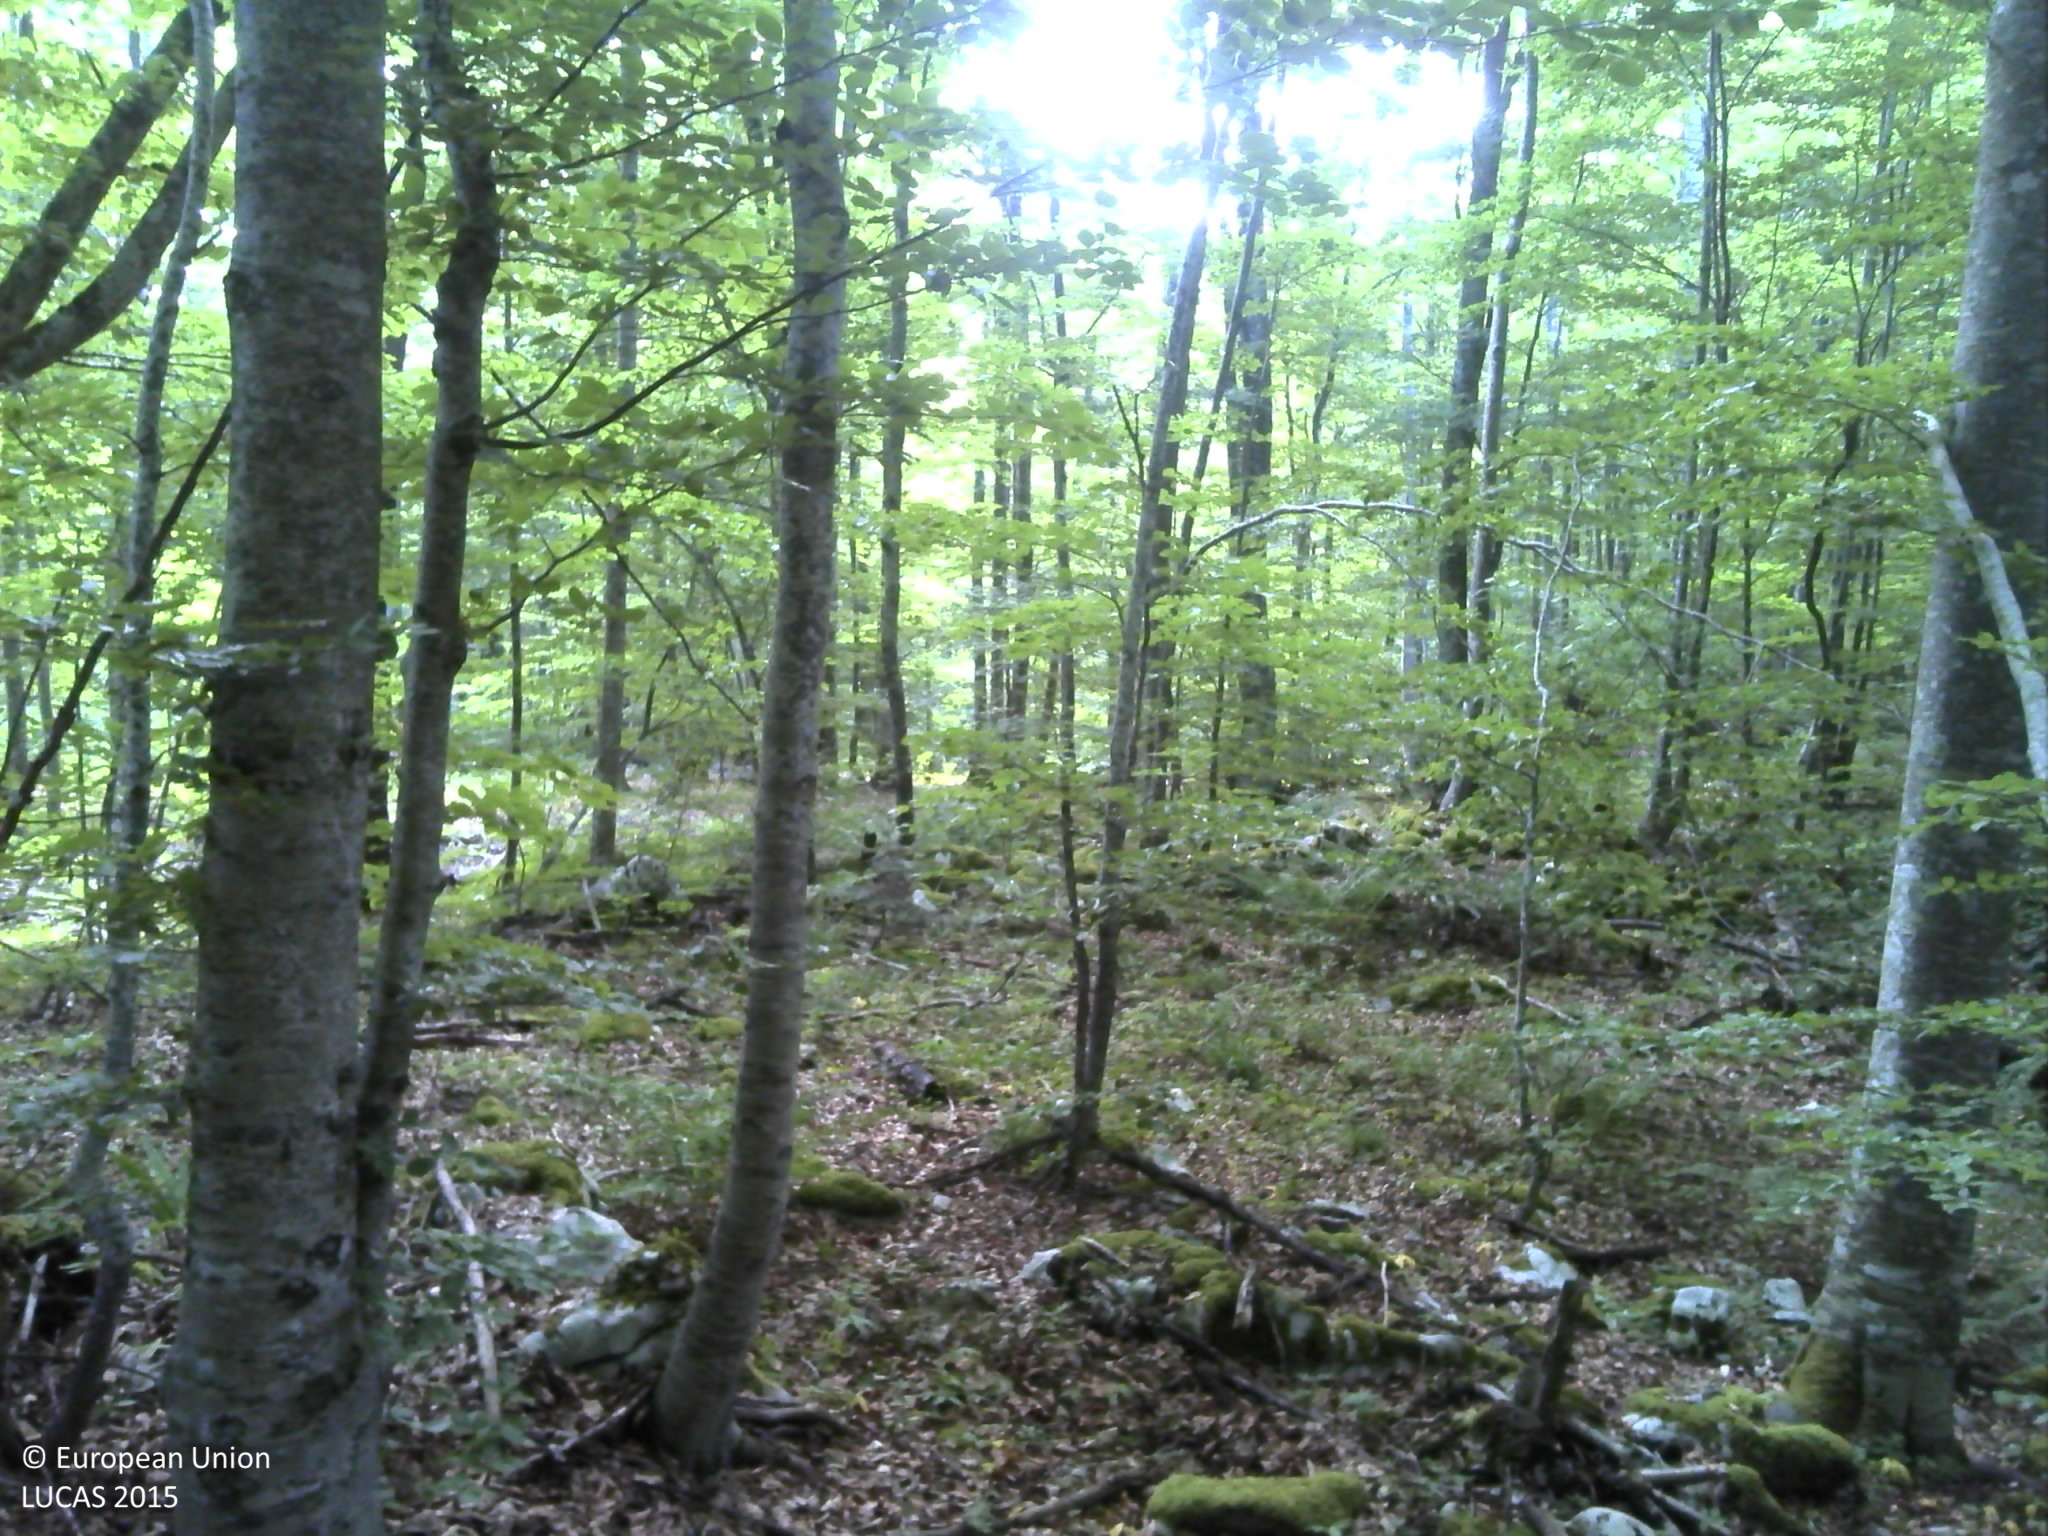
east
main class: Woodland
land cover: Broadleaved woodland
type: mountainous beech forest
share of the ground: > 75 %
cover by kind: broadleaved forest trees 90 %, consolidated bare surface 10 %
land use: Forestry
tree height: > 5 m
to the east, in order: Broadleaved woodland; Tracks; Broadleaved woodland
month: June
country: HR
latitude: 44.5983
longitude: 15.9026
